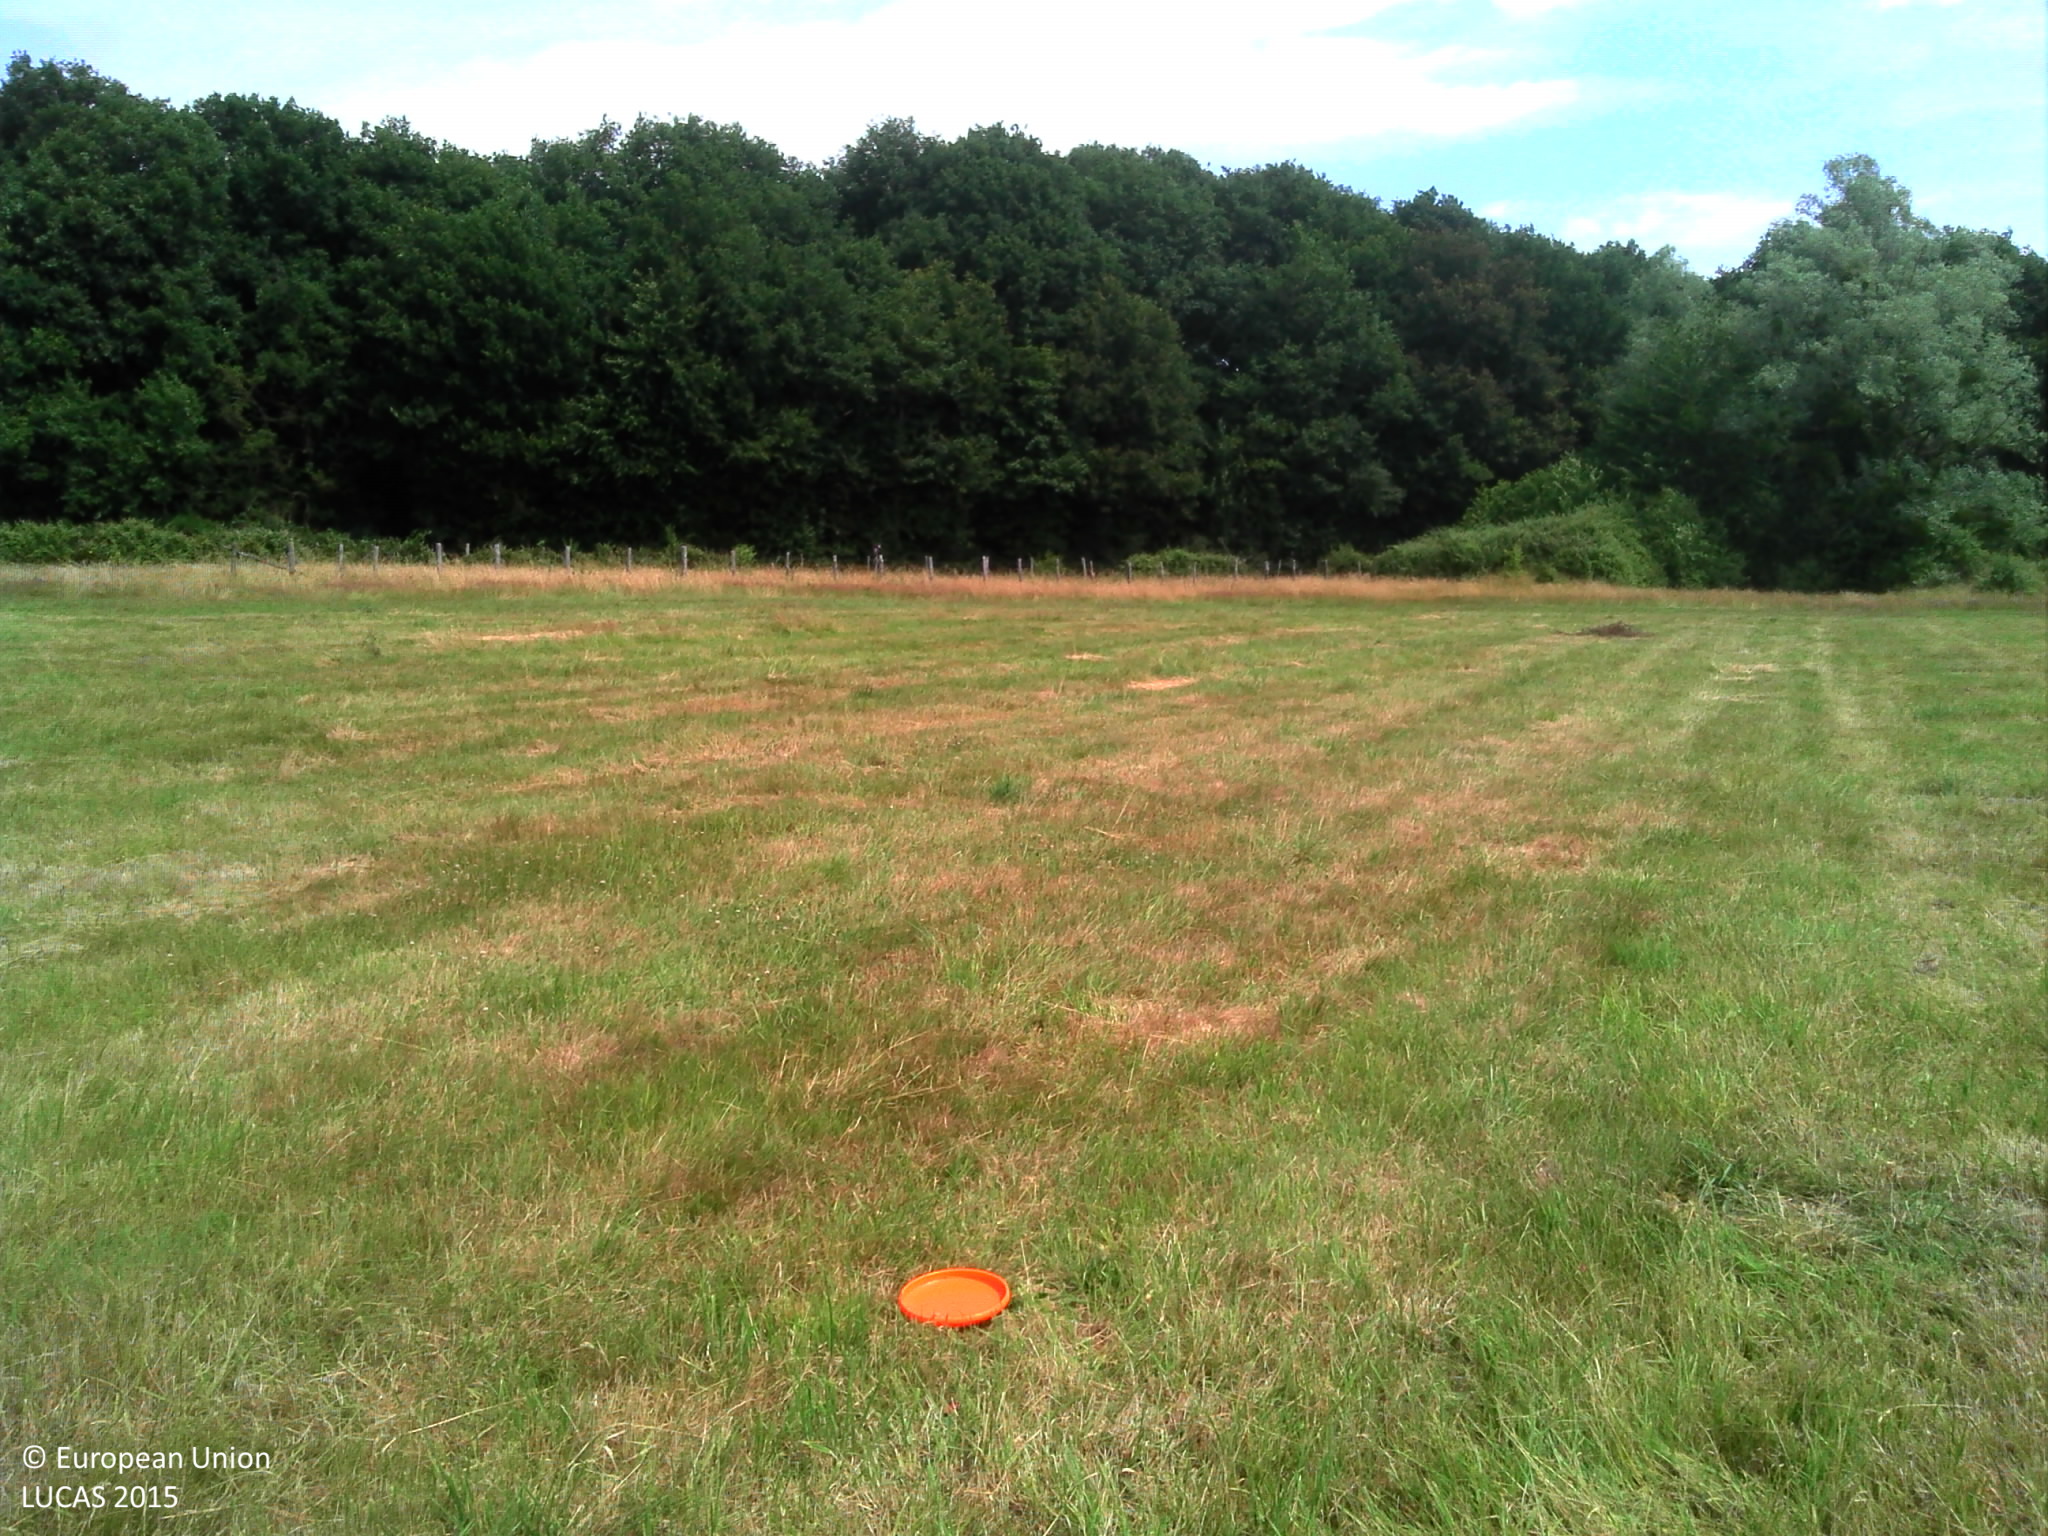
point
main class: Grassland
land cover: Grassland without tree/shrub cover
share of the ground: > 75 %
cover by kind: herbaceous plants 100 %
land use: Agriculture (excluding fallow land and kitchen gardens)
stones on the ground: < 10 %
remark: Harvested field
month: June
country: FR
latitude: 47.5225
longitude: 0.2949
